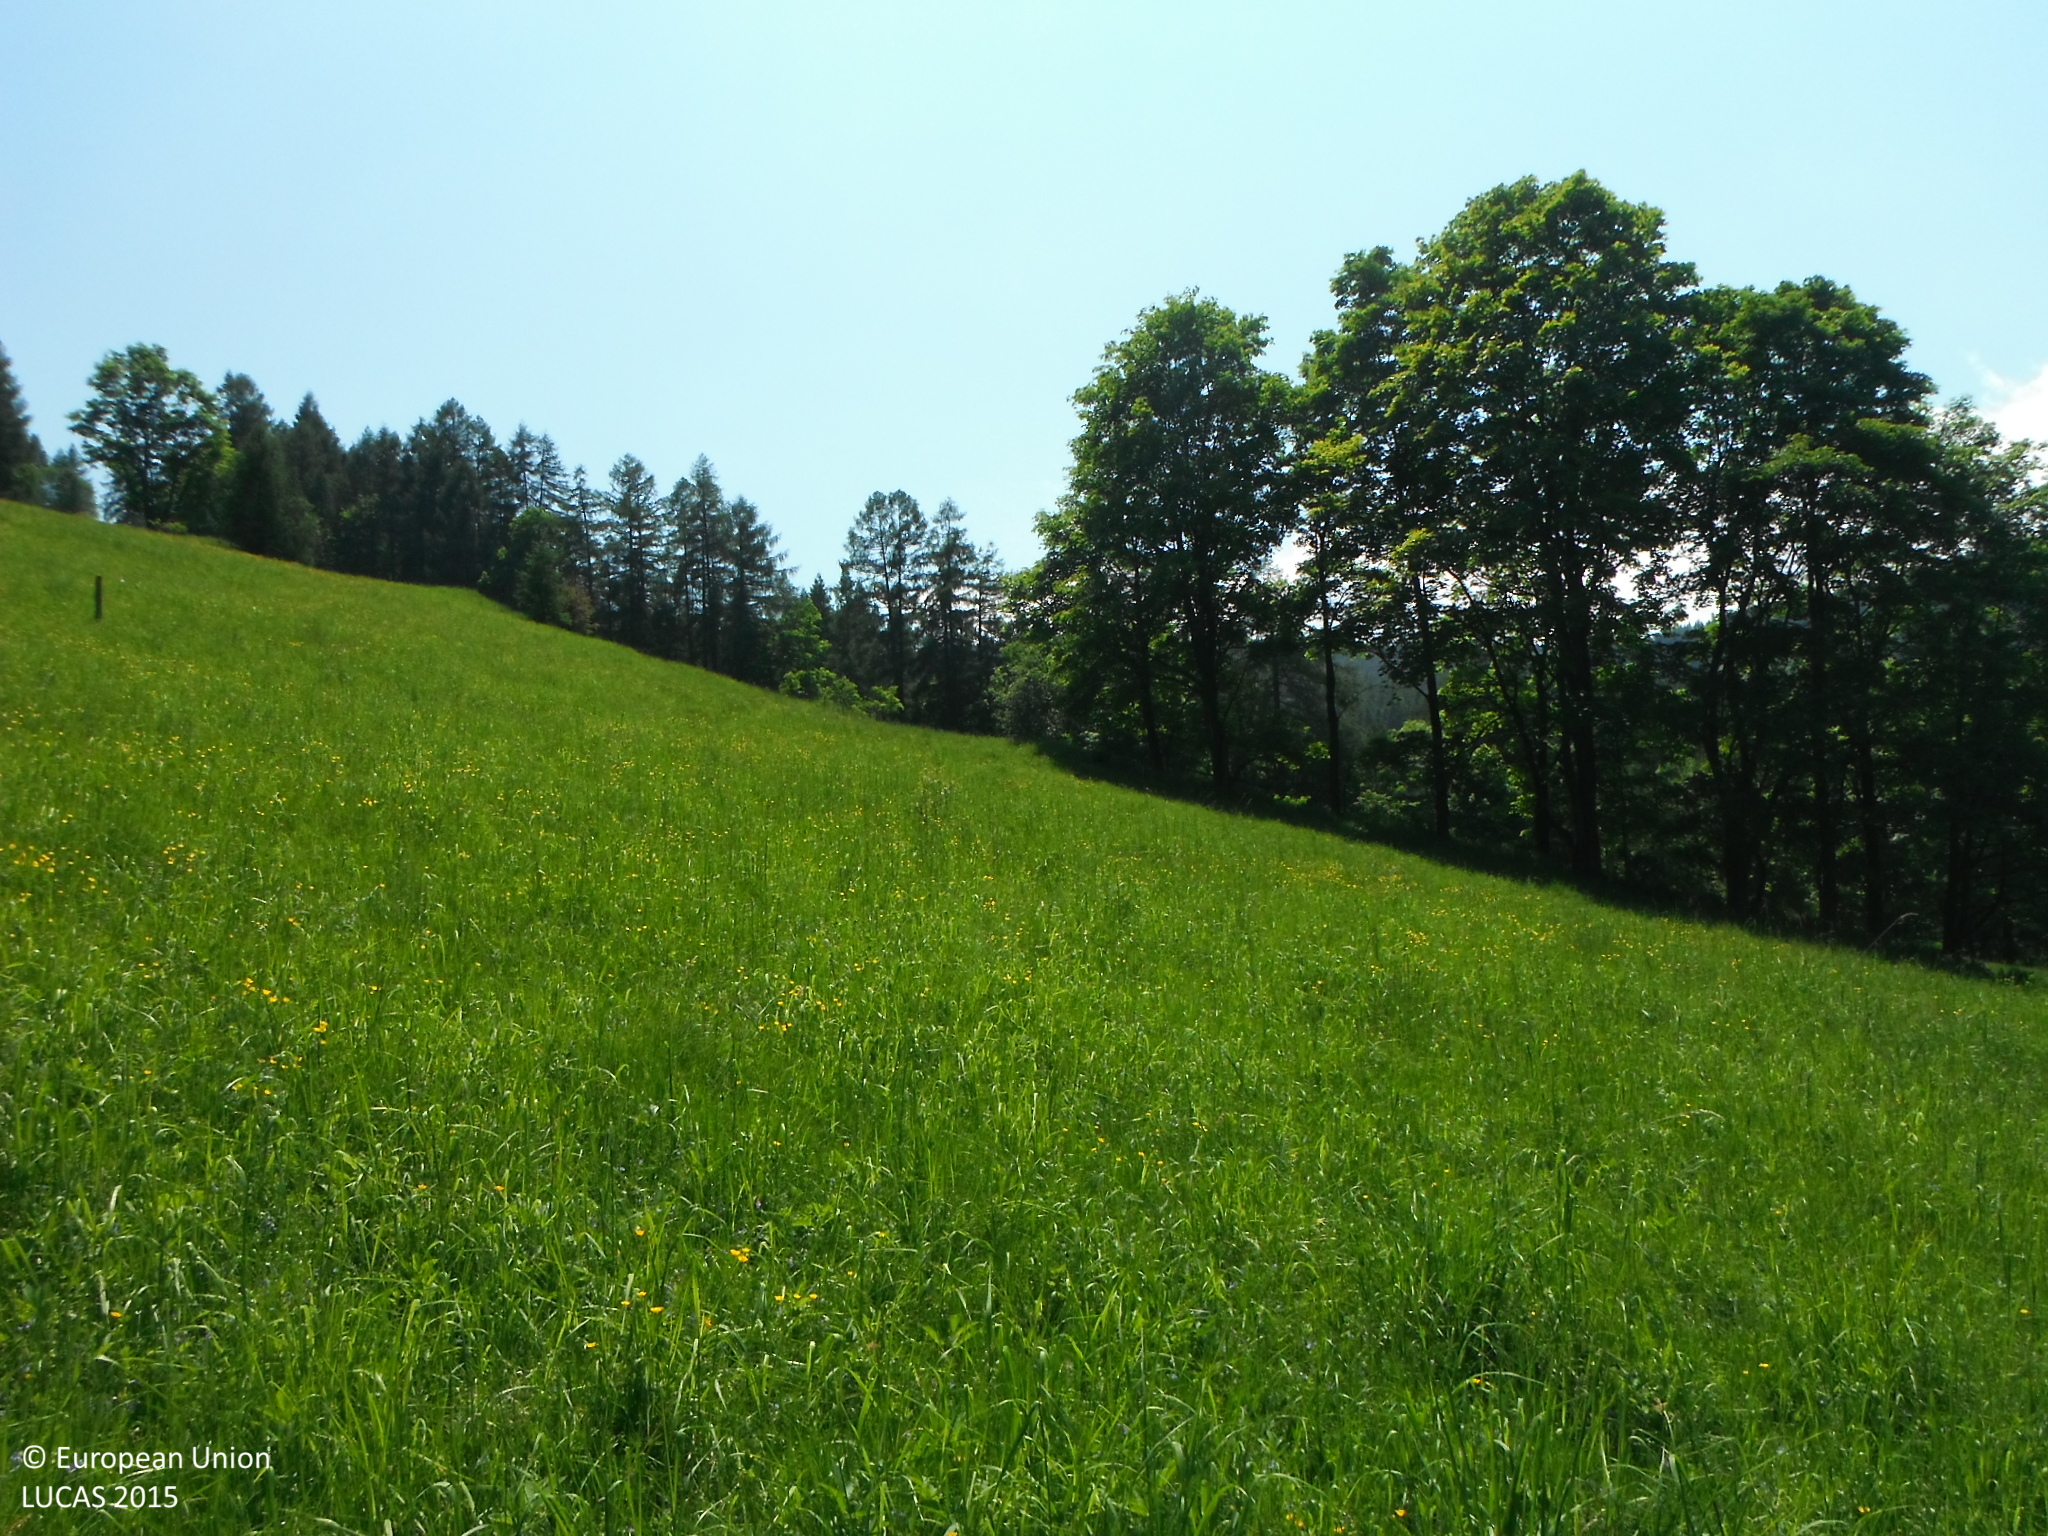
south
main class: Grassland
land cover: Grassland without tree/shrub cover
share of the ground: > 75 %
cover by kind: herbaceous plants 100 %
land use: Agriculture (excluding fallow land and kitchen gardens)
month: June
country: SK
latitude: 49.2963
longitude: 20.3341
